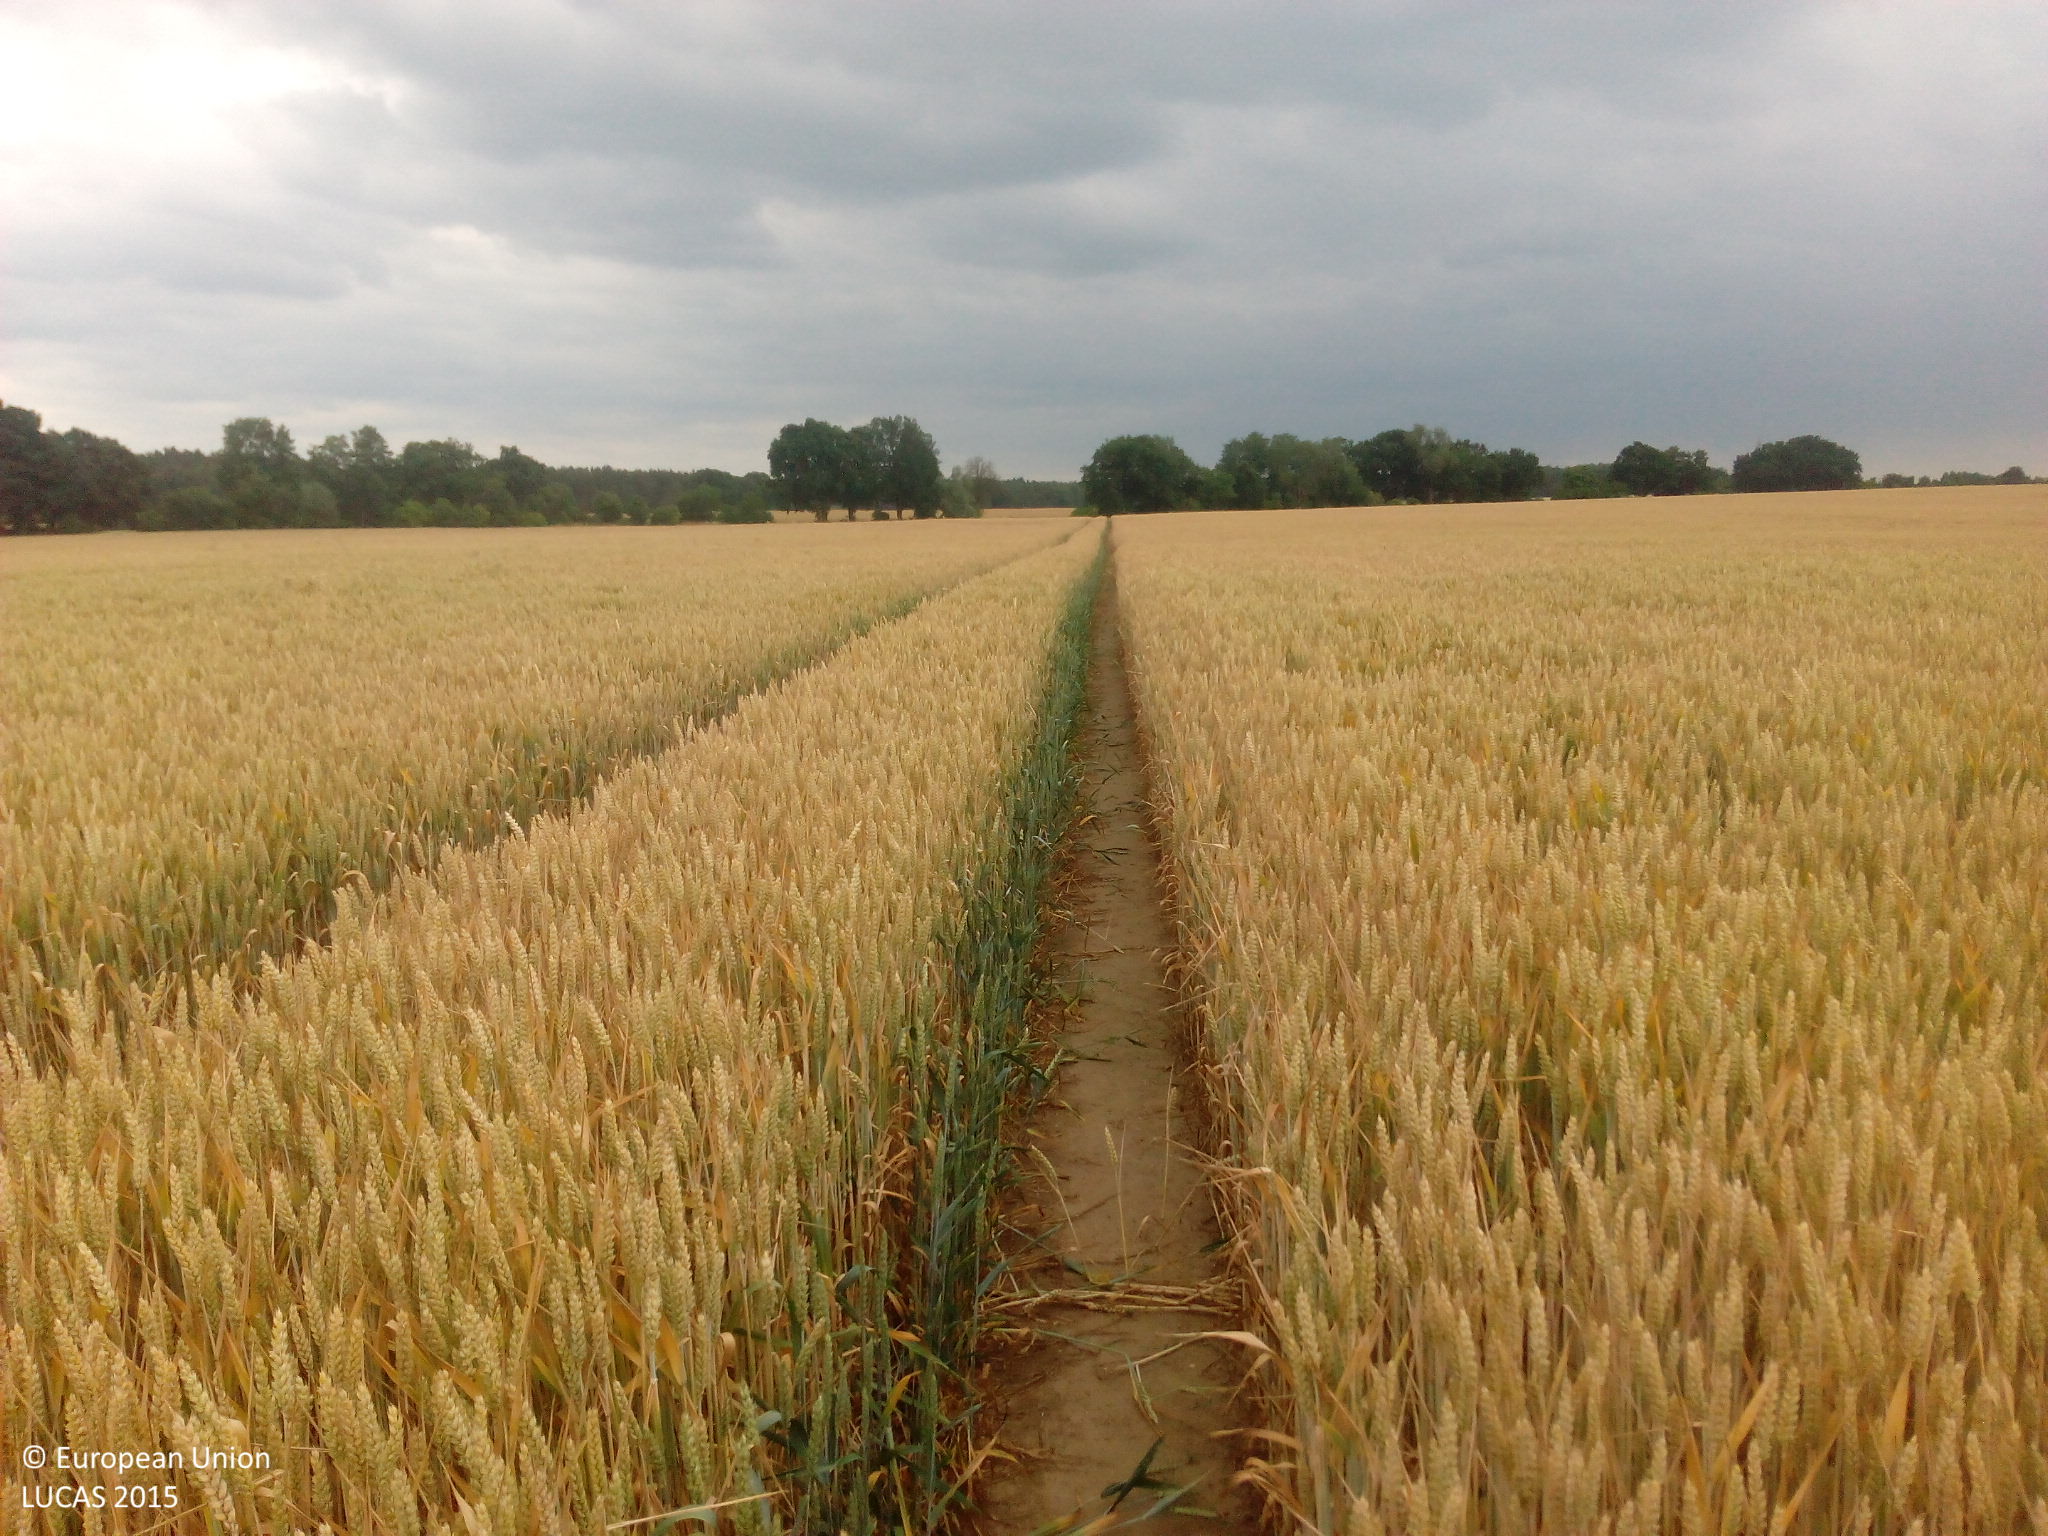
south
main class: Cropland
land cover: Common wheat
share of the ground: > 75 %
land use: Agriculture (excluding fallow land and kitchen gardens)
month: July
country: DE
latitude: 52.9120
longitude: 12.3341
